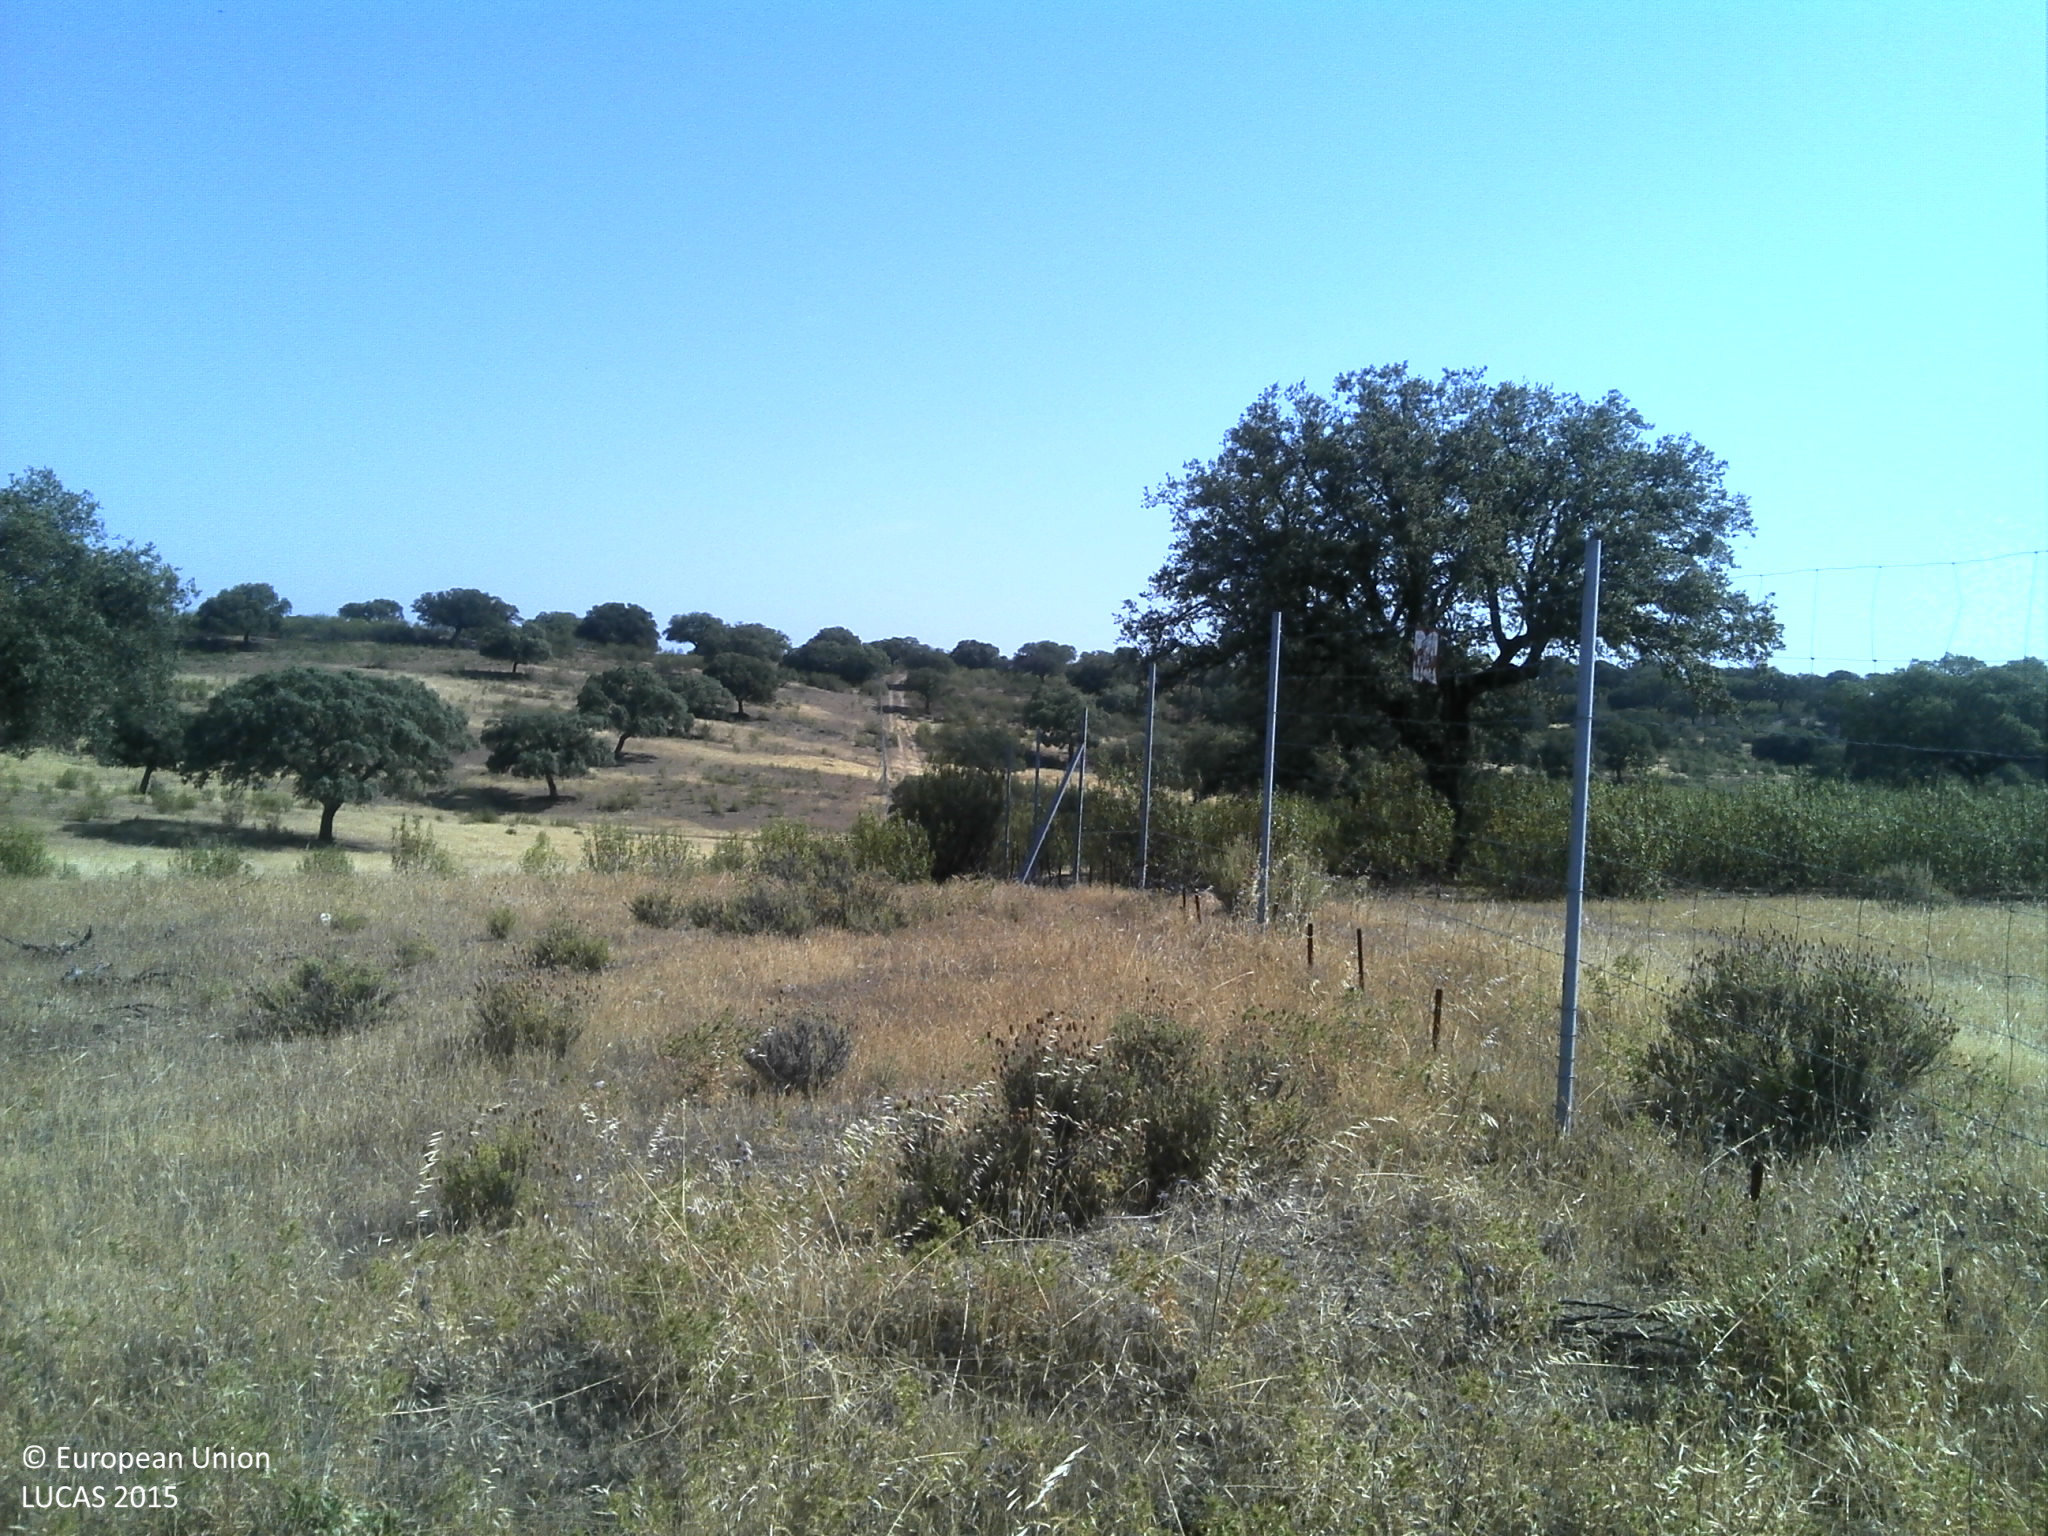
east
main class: Woodland
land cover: Broadleaved woodland
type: broadleaved evergreen forest
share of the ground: 25 - 50 %
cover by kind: shrubs 45 %, broadleaved forest trees 30 %, herbaceous plants 15 %, unconsolidated bare surface 5 %
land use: Forestry
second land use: Other primary production
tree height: > 5 m
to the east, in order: Broadleaved woodland; Shrubland with sparse tree cover; Tracks; Shrubland with sparse tree cover; Broadleaved woodland; Tracks; Broadleaved woodland
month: June
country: PT
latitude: 39.6884
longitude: -7.0284
